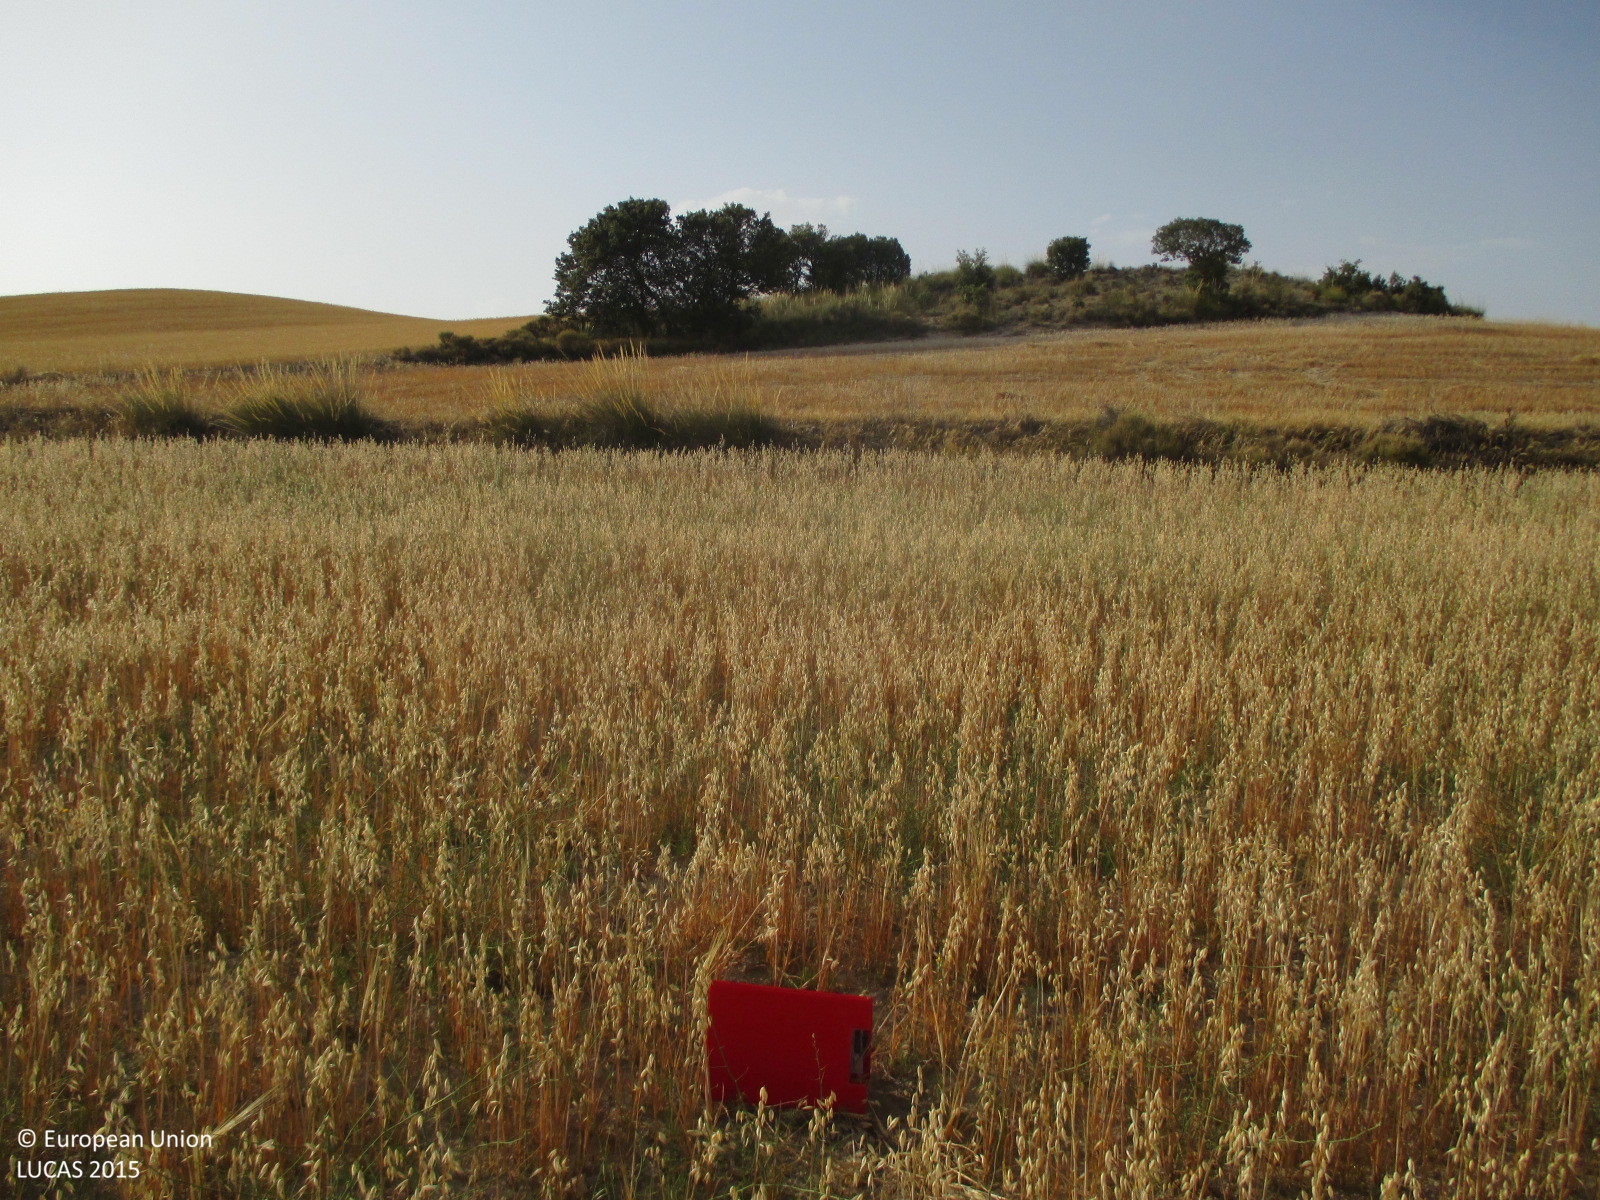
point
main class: Cropland
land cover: Oats
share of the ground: 50 - 75 %
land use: Agriculture (excluding fallow land and kitchen gardens)
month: July
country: ES
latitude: 37.7578
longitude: -2.3944
